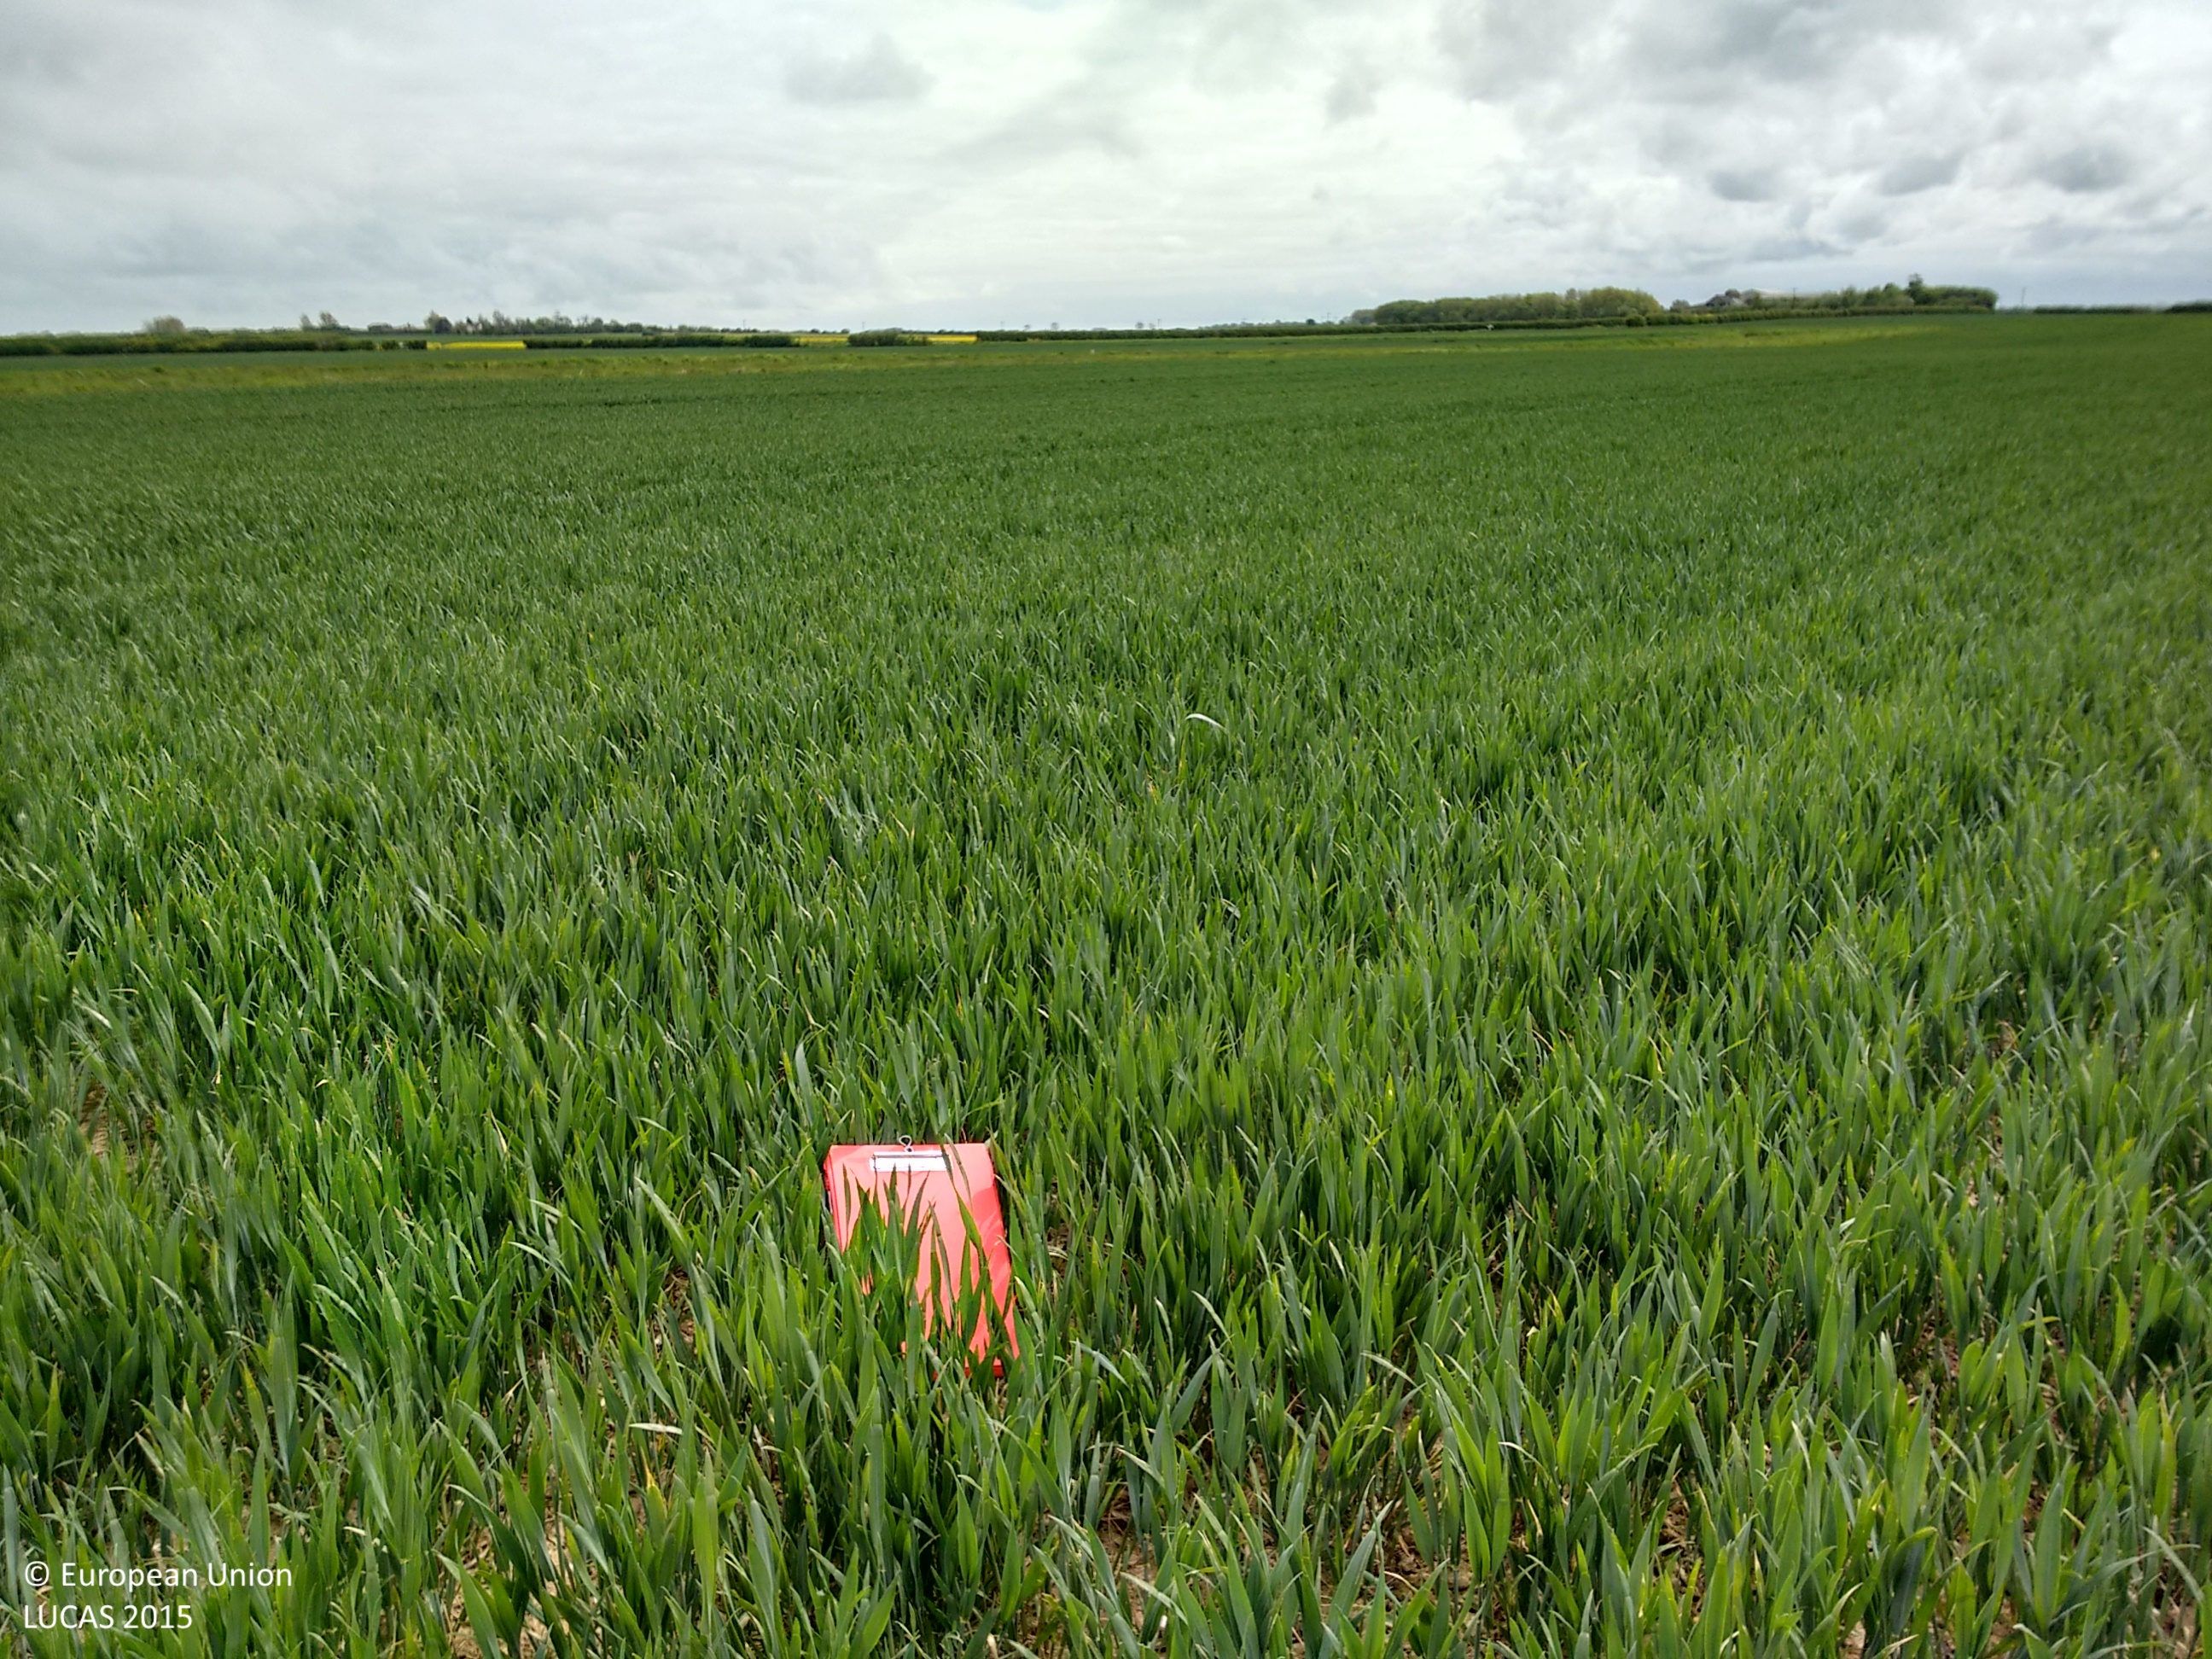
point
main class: Cropland
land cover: Common wheat
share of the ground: > 75 %
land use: Agriculture (excluding fallow land and kitchen gardens)
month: May
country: GB
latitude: 53.8249
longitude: -0.1661
